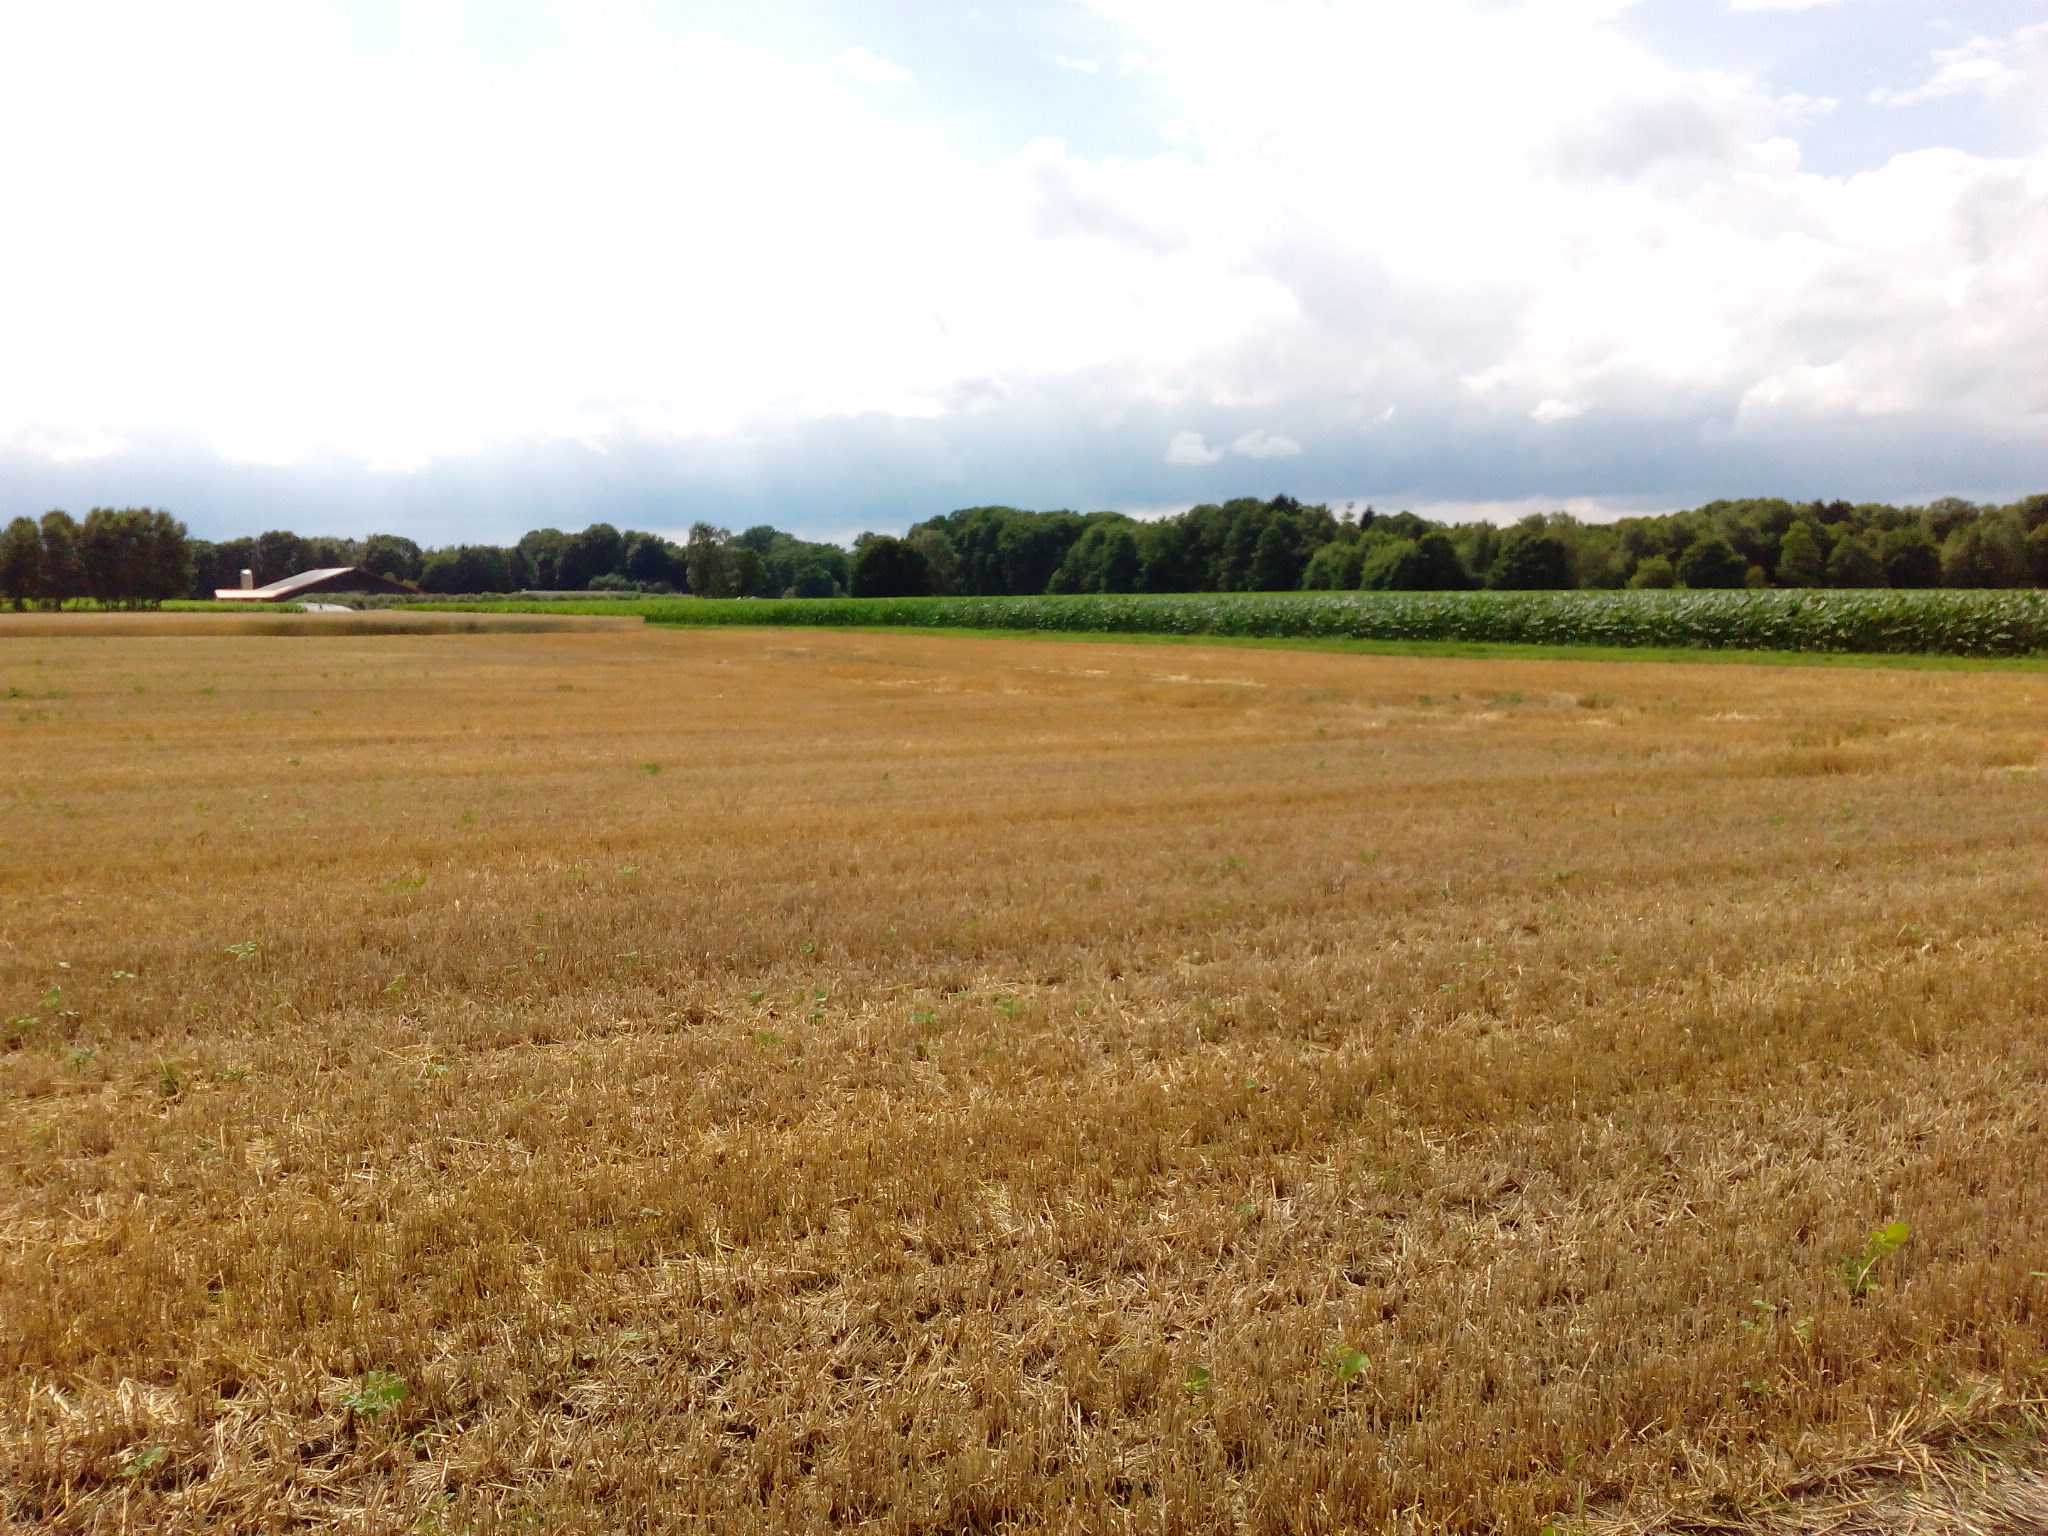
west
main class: Cropland
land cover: Rye
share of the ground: > 75 %
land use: Agriculture (excluding fallow land and kitchen gardens)
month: July
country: DE
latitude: 52.9705
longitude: 9.8660
